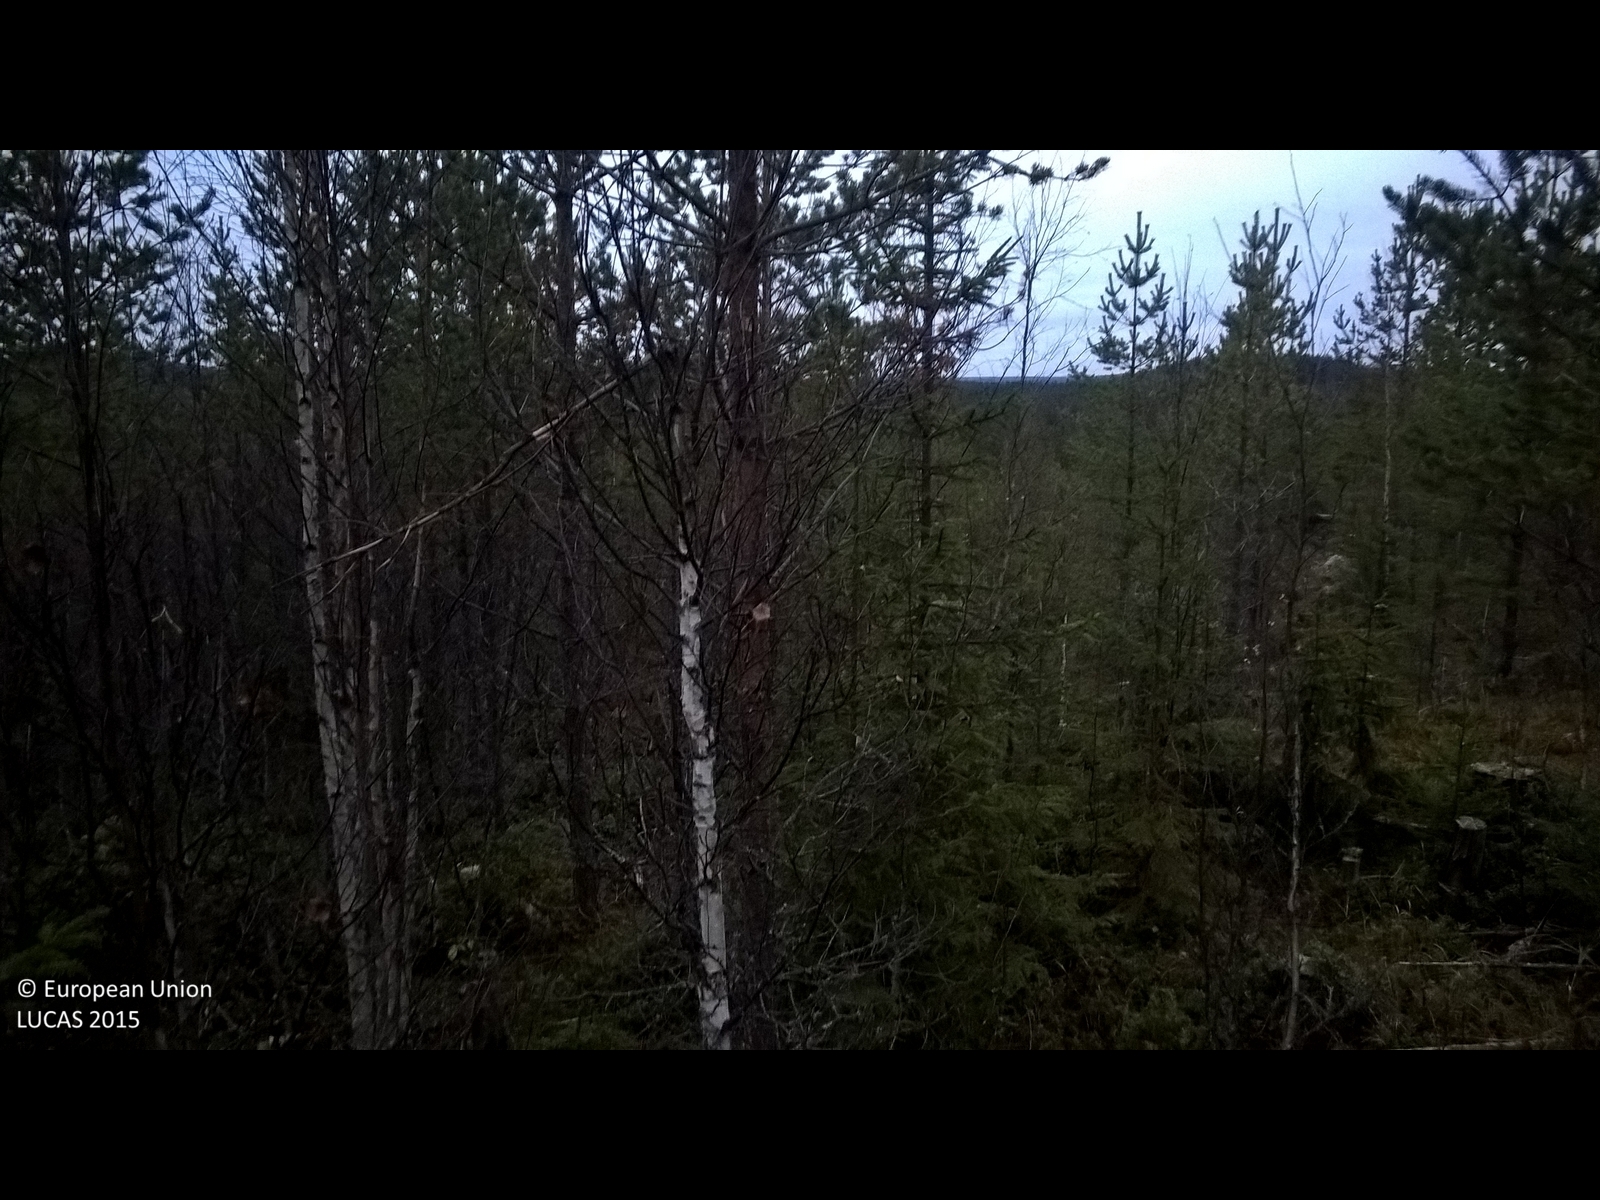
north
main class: Woodland
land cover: Pine dominated mixed woodland
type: exotic forest
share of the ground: 50 - 75 %
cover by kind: coniferous forest trees 40 %, broadleaved forest trees 35 %, lichens and mosses 15 %, shrubs 5 %, herbaceous plants 5 %
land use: Forestry
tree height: > 5 m
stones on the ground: < 10 %
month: October
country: SE
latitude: 62.8089
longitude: 16.2350
